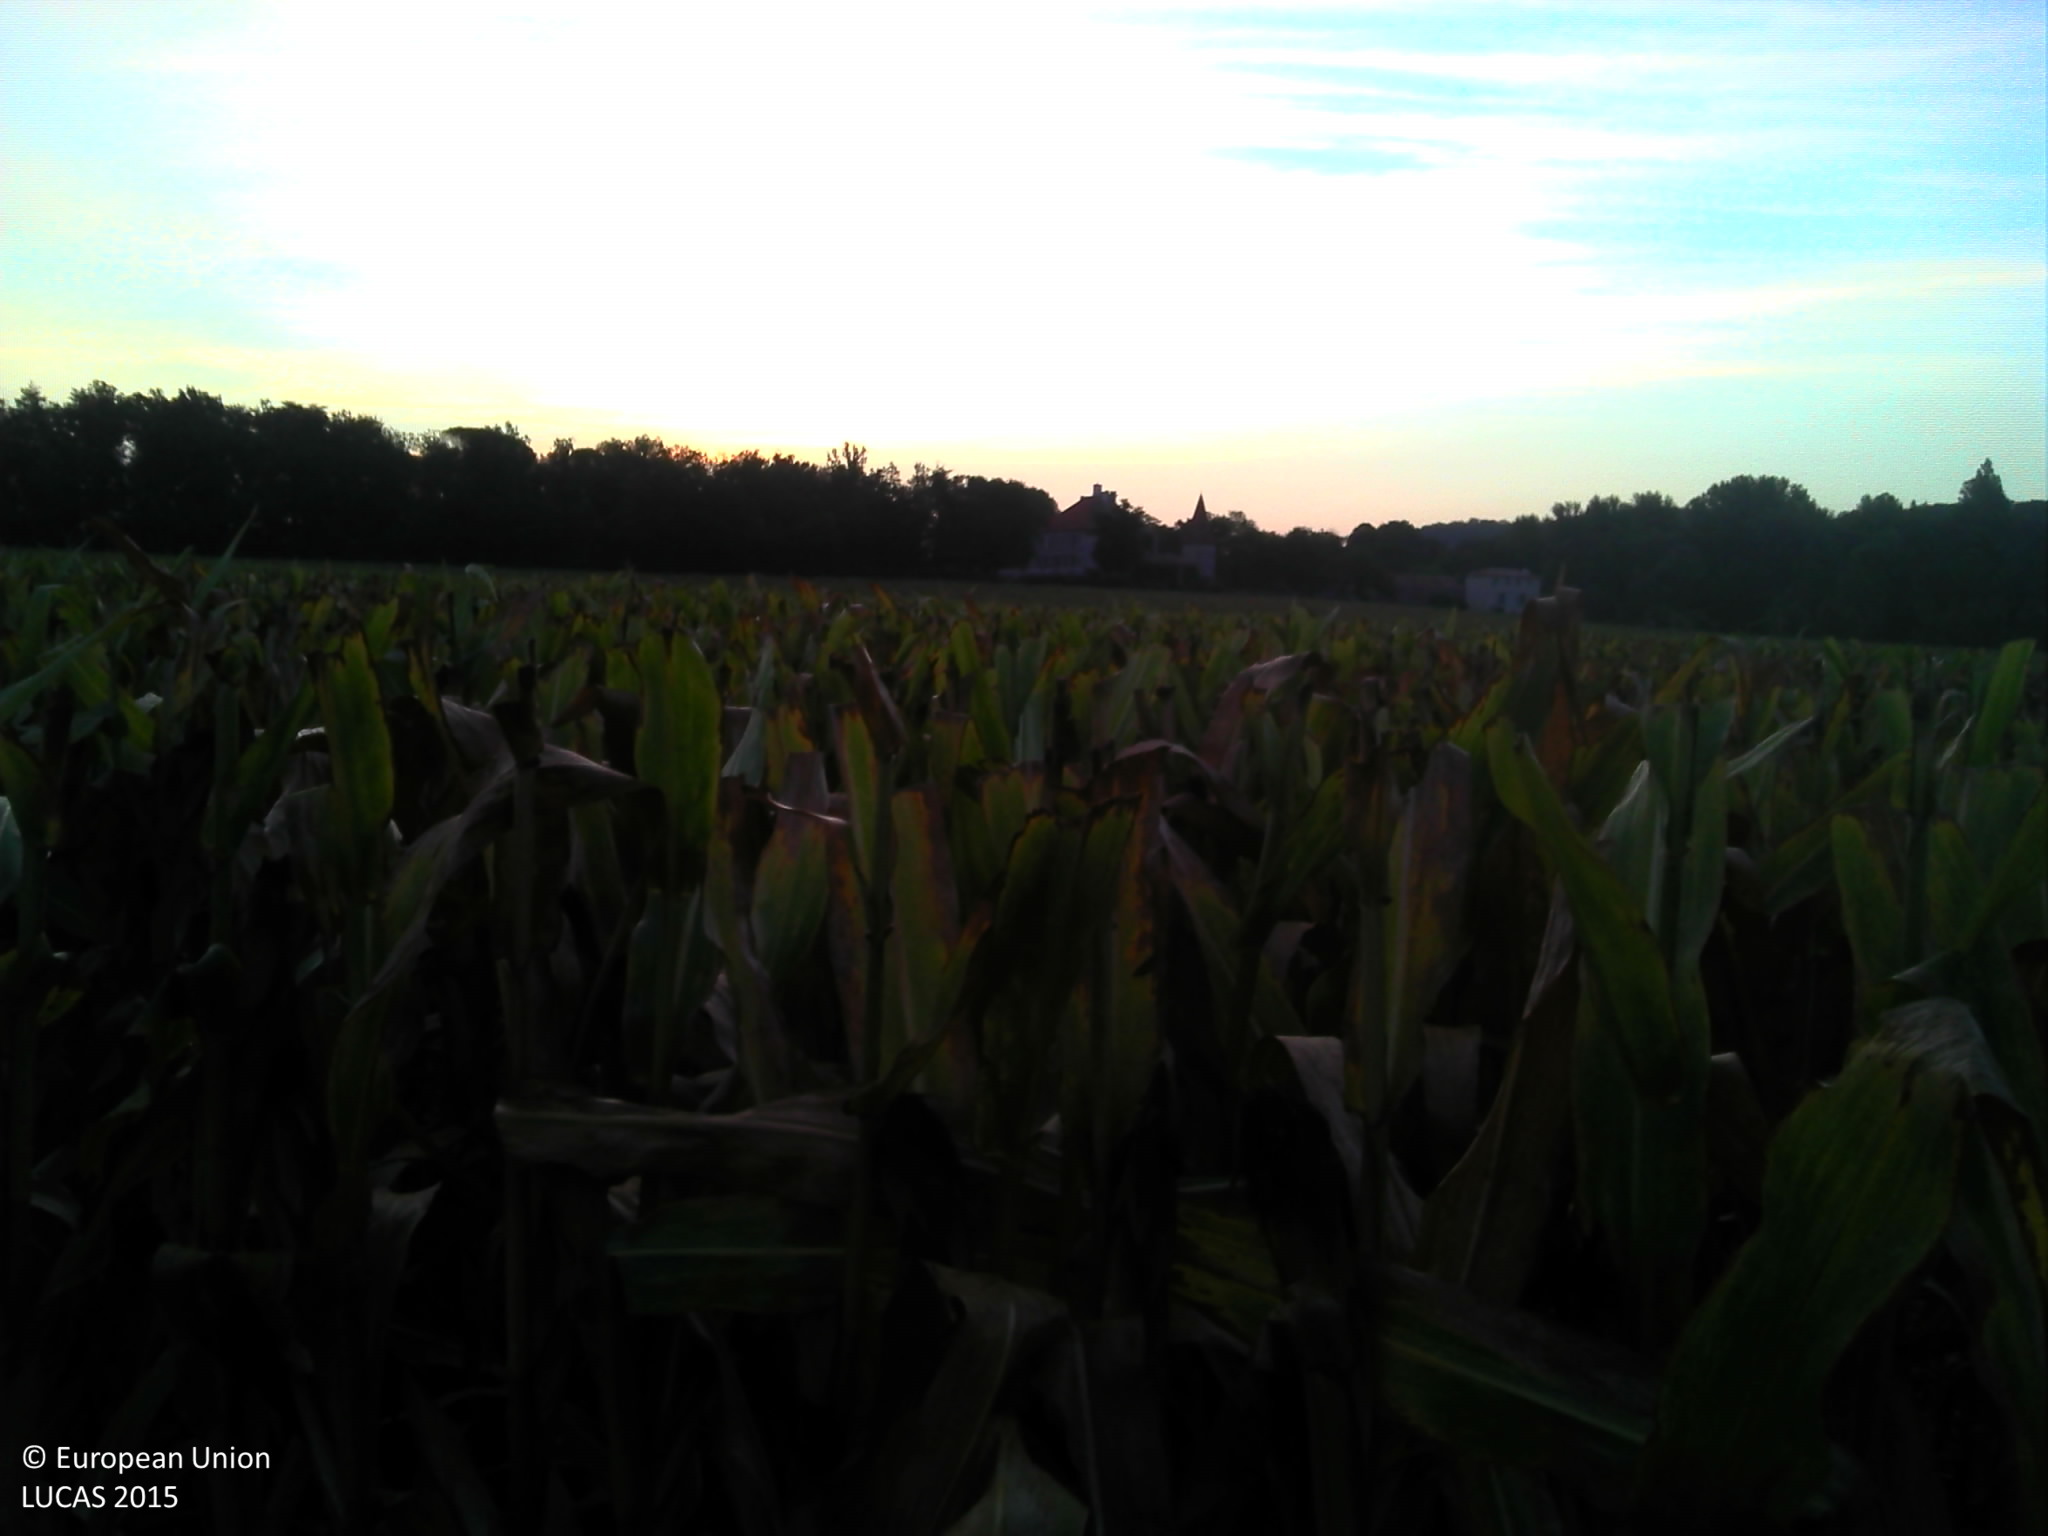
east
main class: Cropland
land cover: Maize
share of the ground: > 75 %
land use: Agriculture (excluding fallow land and kitchen gardens)
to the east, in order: Maize
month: August
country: FR
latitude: 44.2855
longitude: 1.2135
